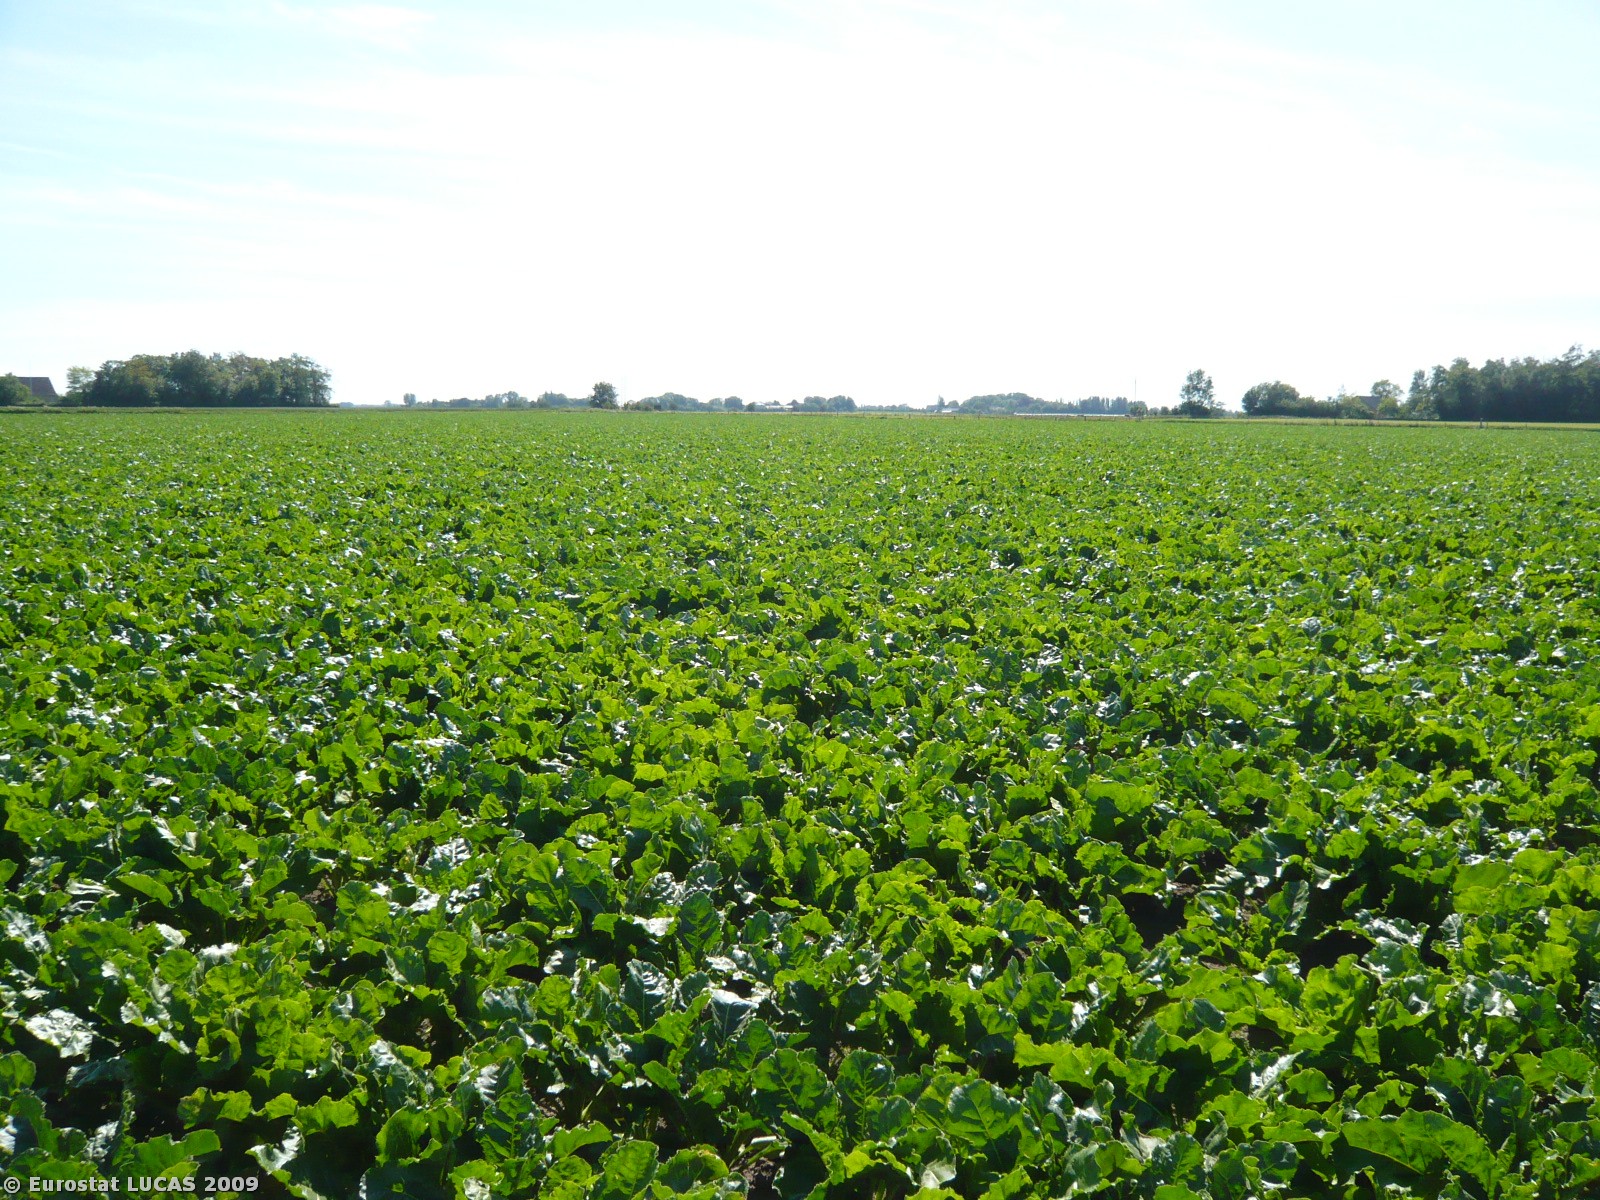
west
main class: Cropland
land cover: Sugar beet
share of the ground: > 75 %
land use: Agriculture (excluding fallow land and kitchen gardens)
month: June
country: DK
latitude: 54.7980
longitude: 11.1969
